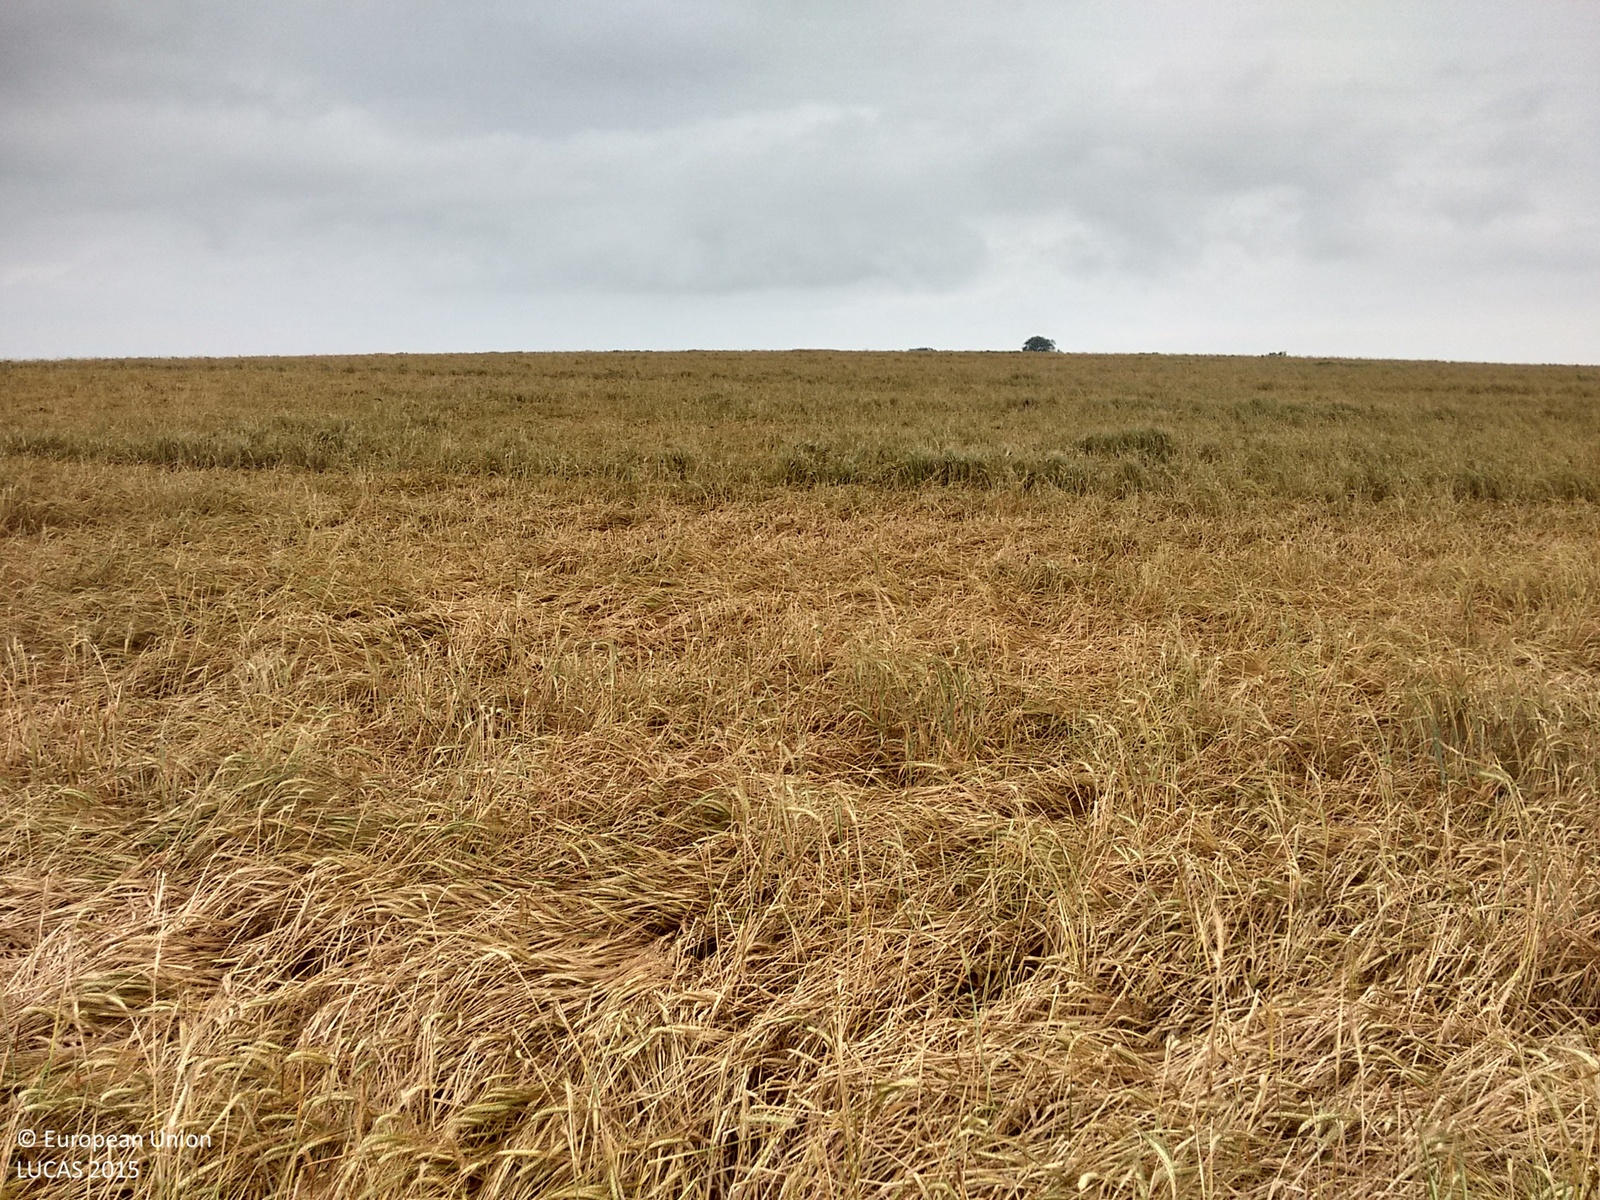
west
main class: Cropland
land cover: Barley
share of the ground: > 75 %
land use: Agriculture (excluding fallow land and kitchen gardens)
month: August
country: GB
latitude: 50.4835
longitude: -4.2919
